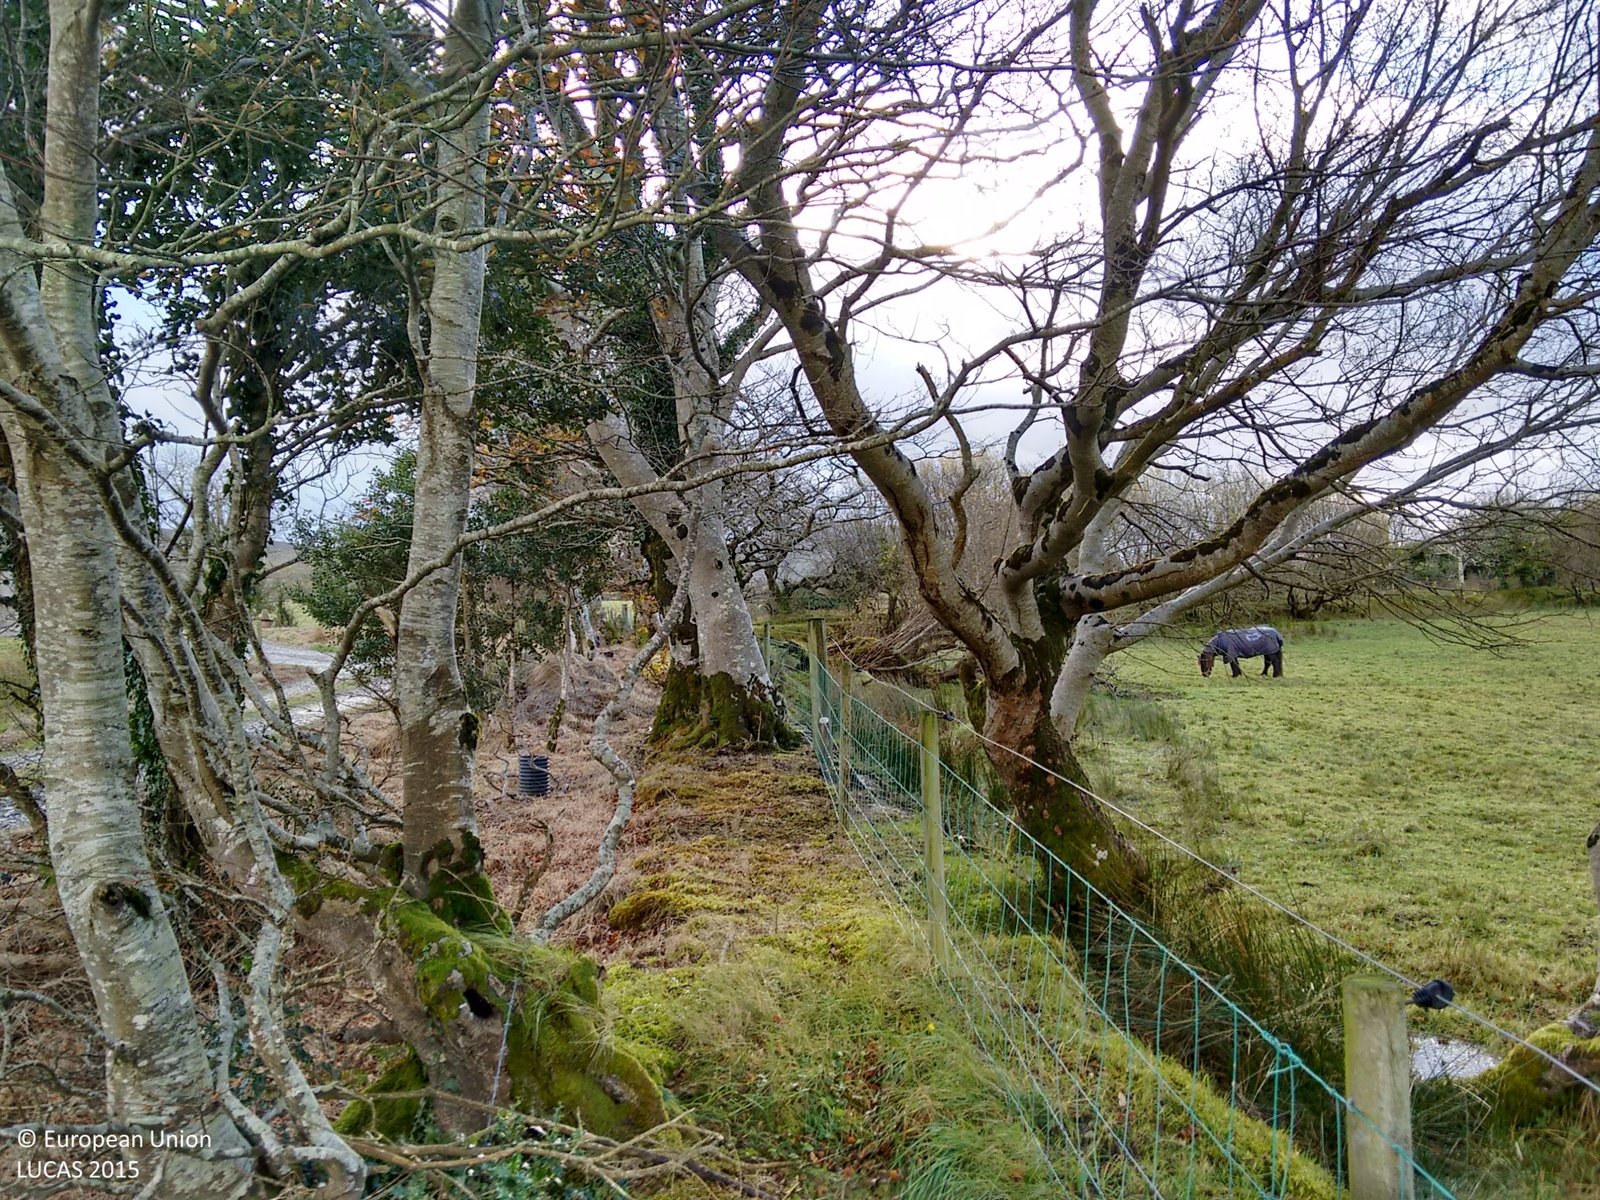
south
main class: Grassland
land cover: Grassland without tree/shrub cover
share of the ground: > 75 %
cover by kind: herbaceous plants 100 %
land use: Agriculture (excluding fallow land and kitchen gardens)
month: November
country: IE
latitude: 54.4289
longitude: -8.2960
